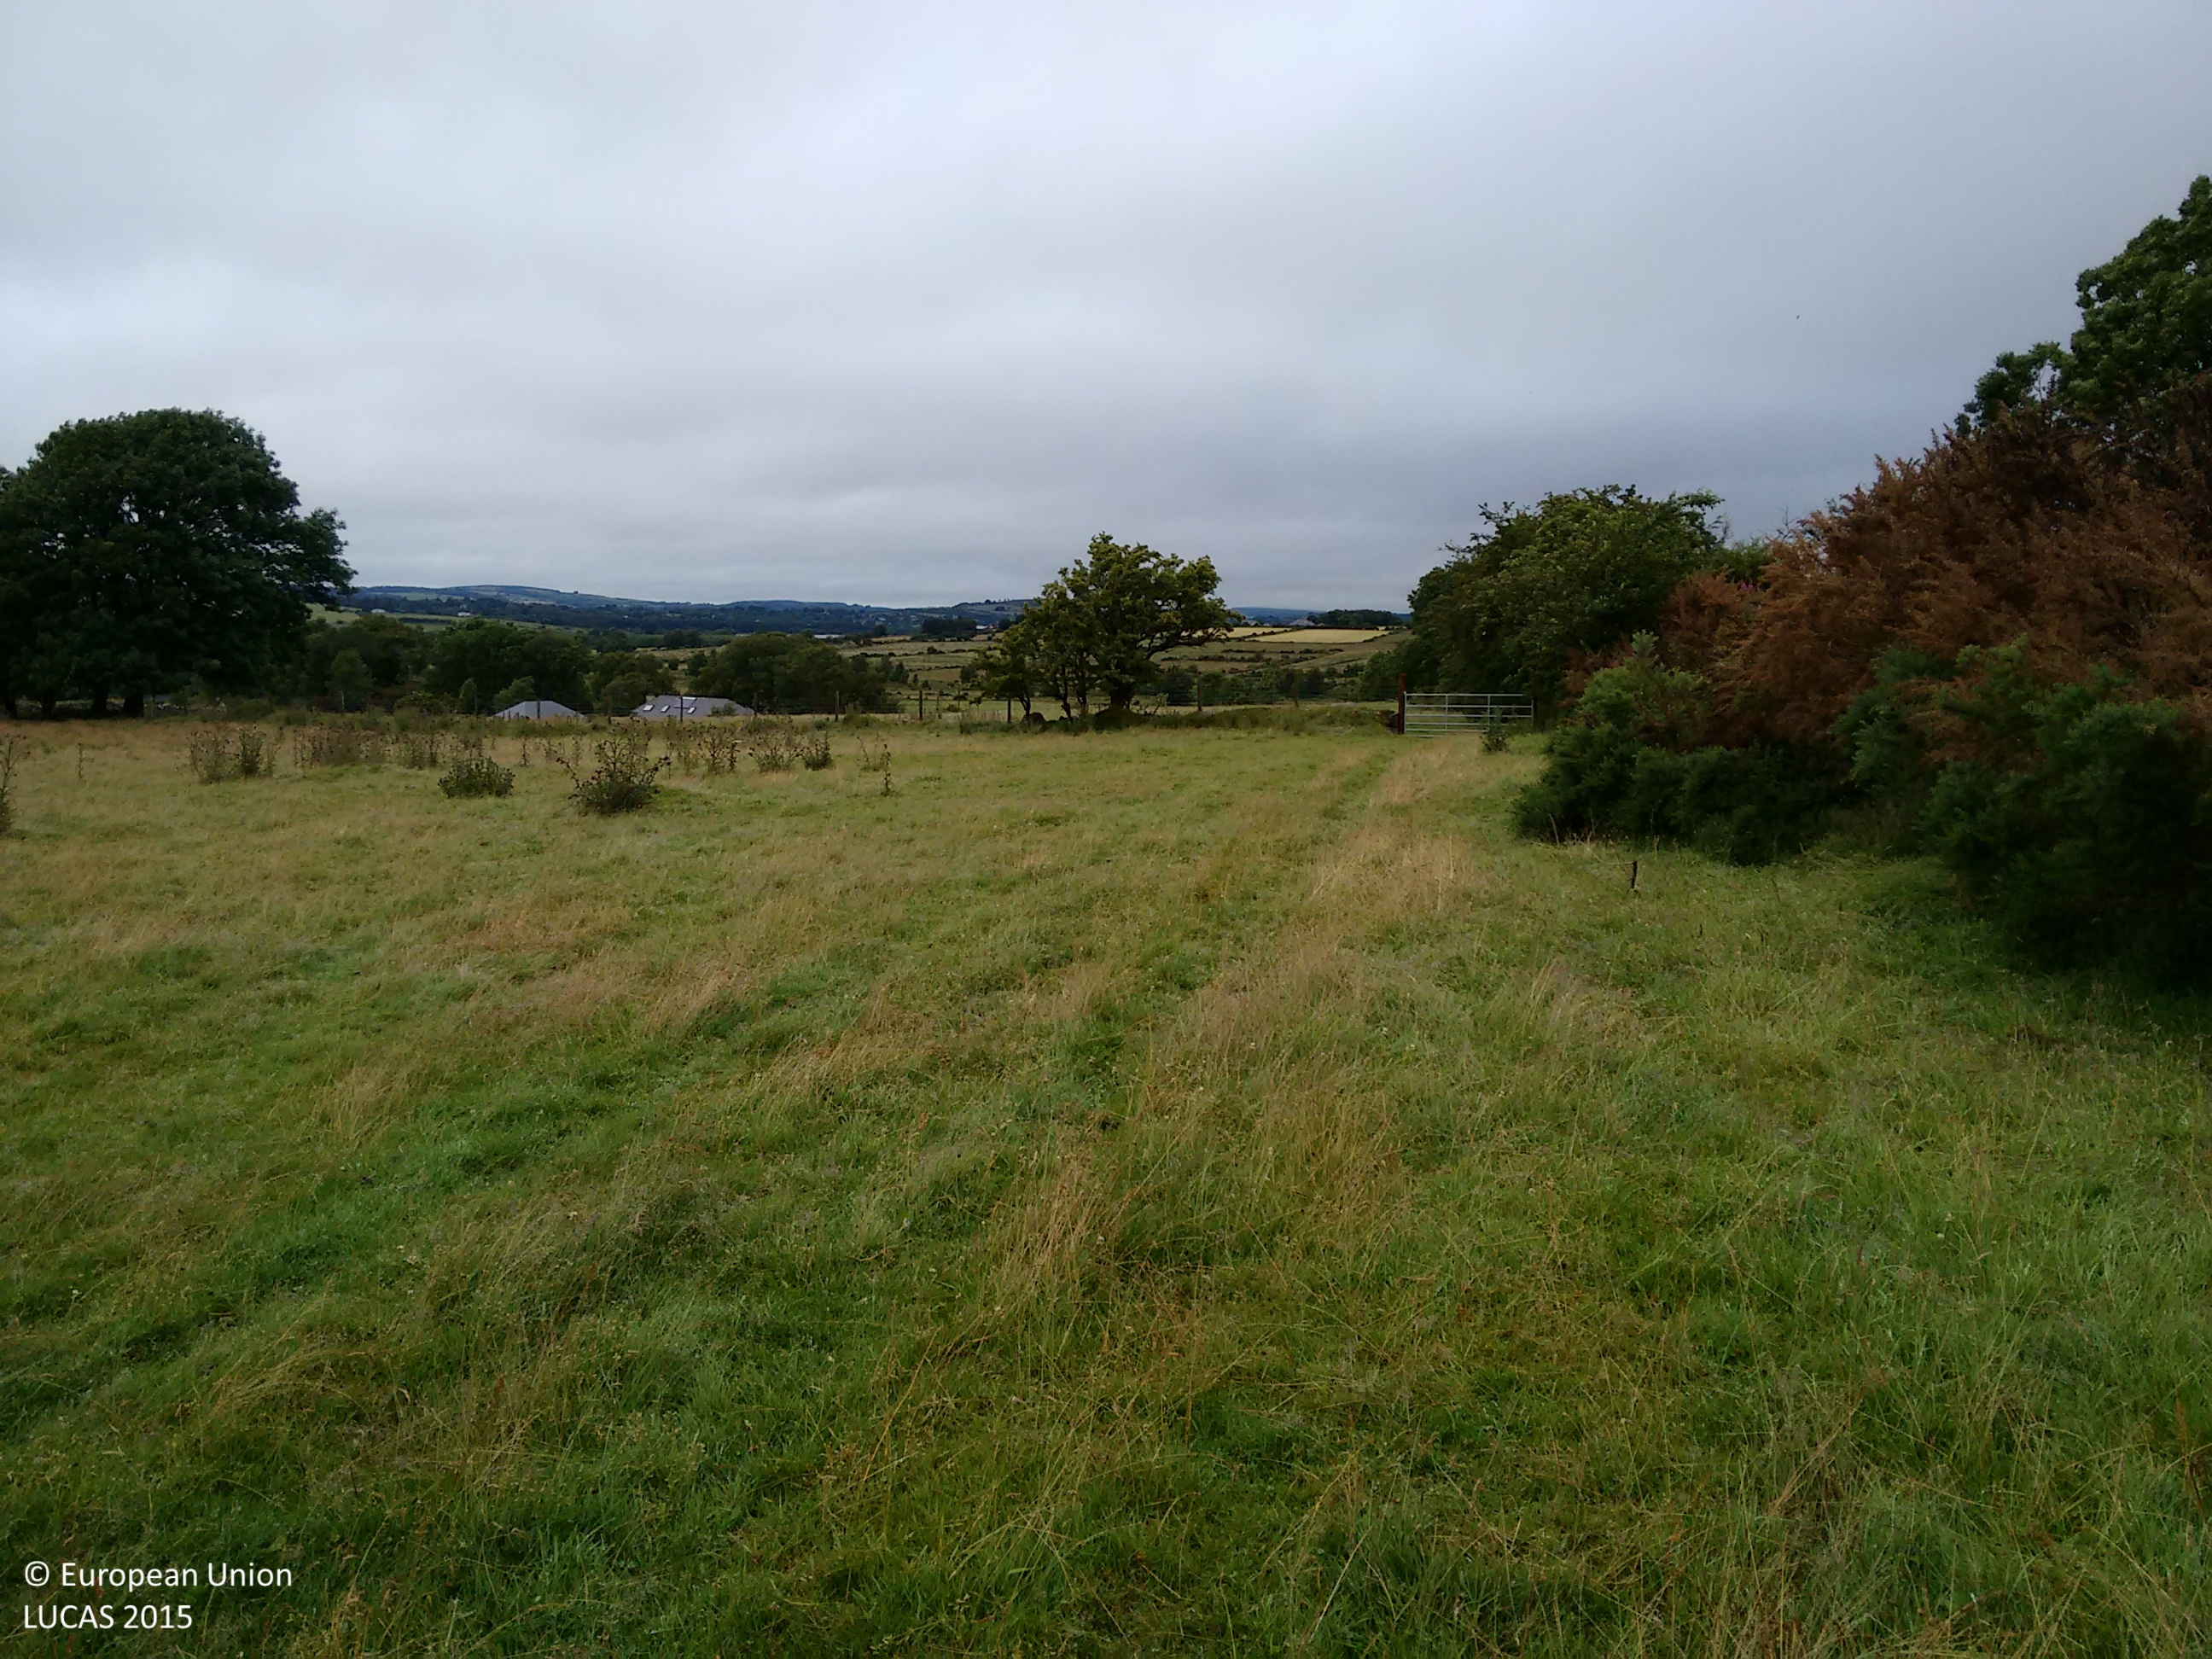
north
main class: Grassland
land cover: Grassland without tree/shrub cover
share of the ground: > 75 %
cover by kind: herbaceous plants 100 %
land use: Agriculture (excluding fallow land and kitchen gardens)
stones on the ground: < 10 %
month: July
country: IE
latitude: 53.0806
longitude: -6.5346
